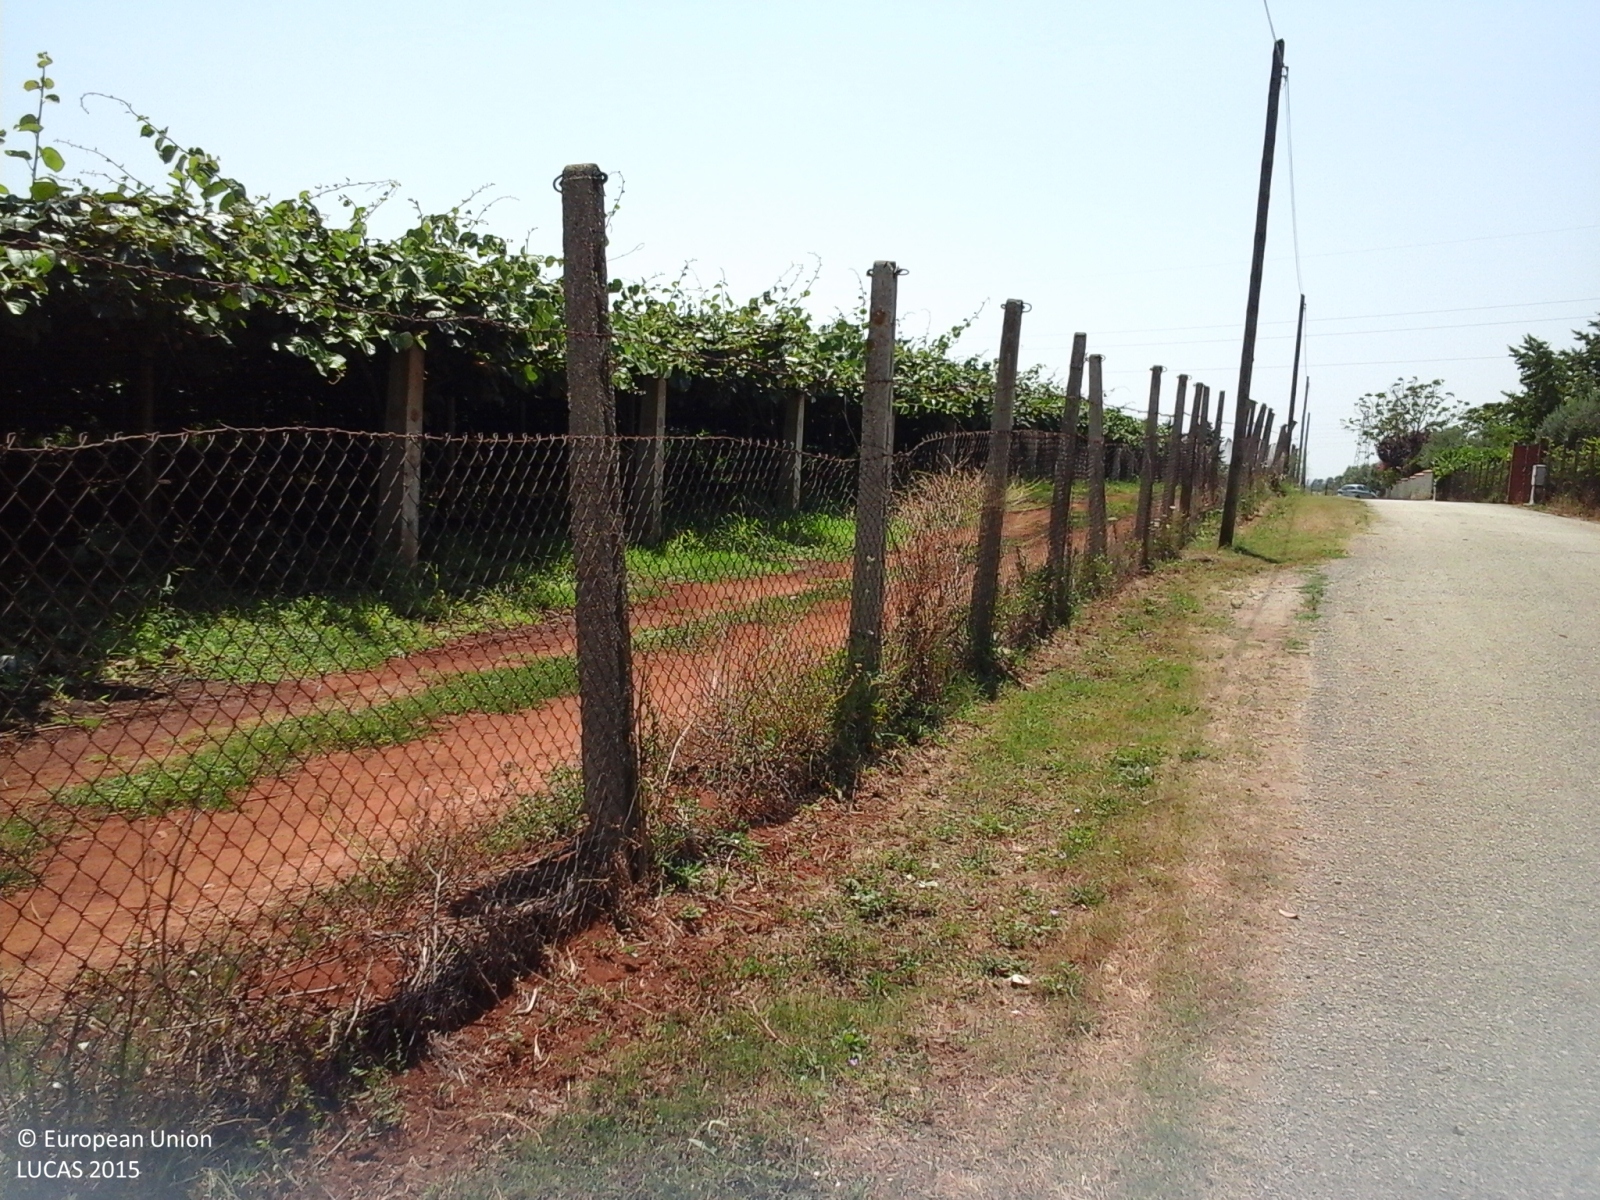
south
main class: Cropland
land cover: Other fruit trees and berries
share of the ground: > 75 %
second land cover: Grassland without tree/shrub cover
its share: > 75 %
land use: Agriculture (excluding fallow land and kitchen gardens)
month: July
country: IT
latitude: 41.6027
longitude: 12.8087
